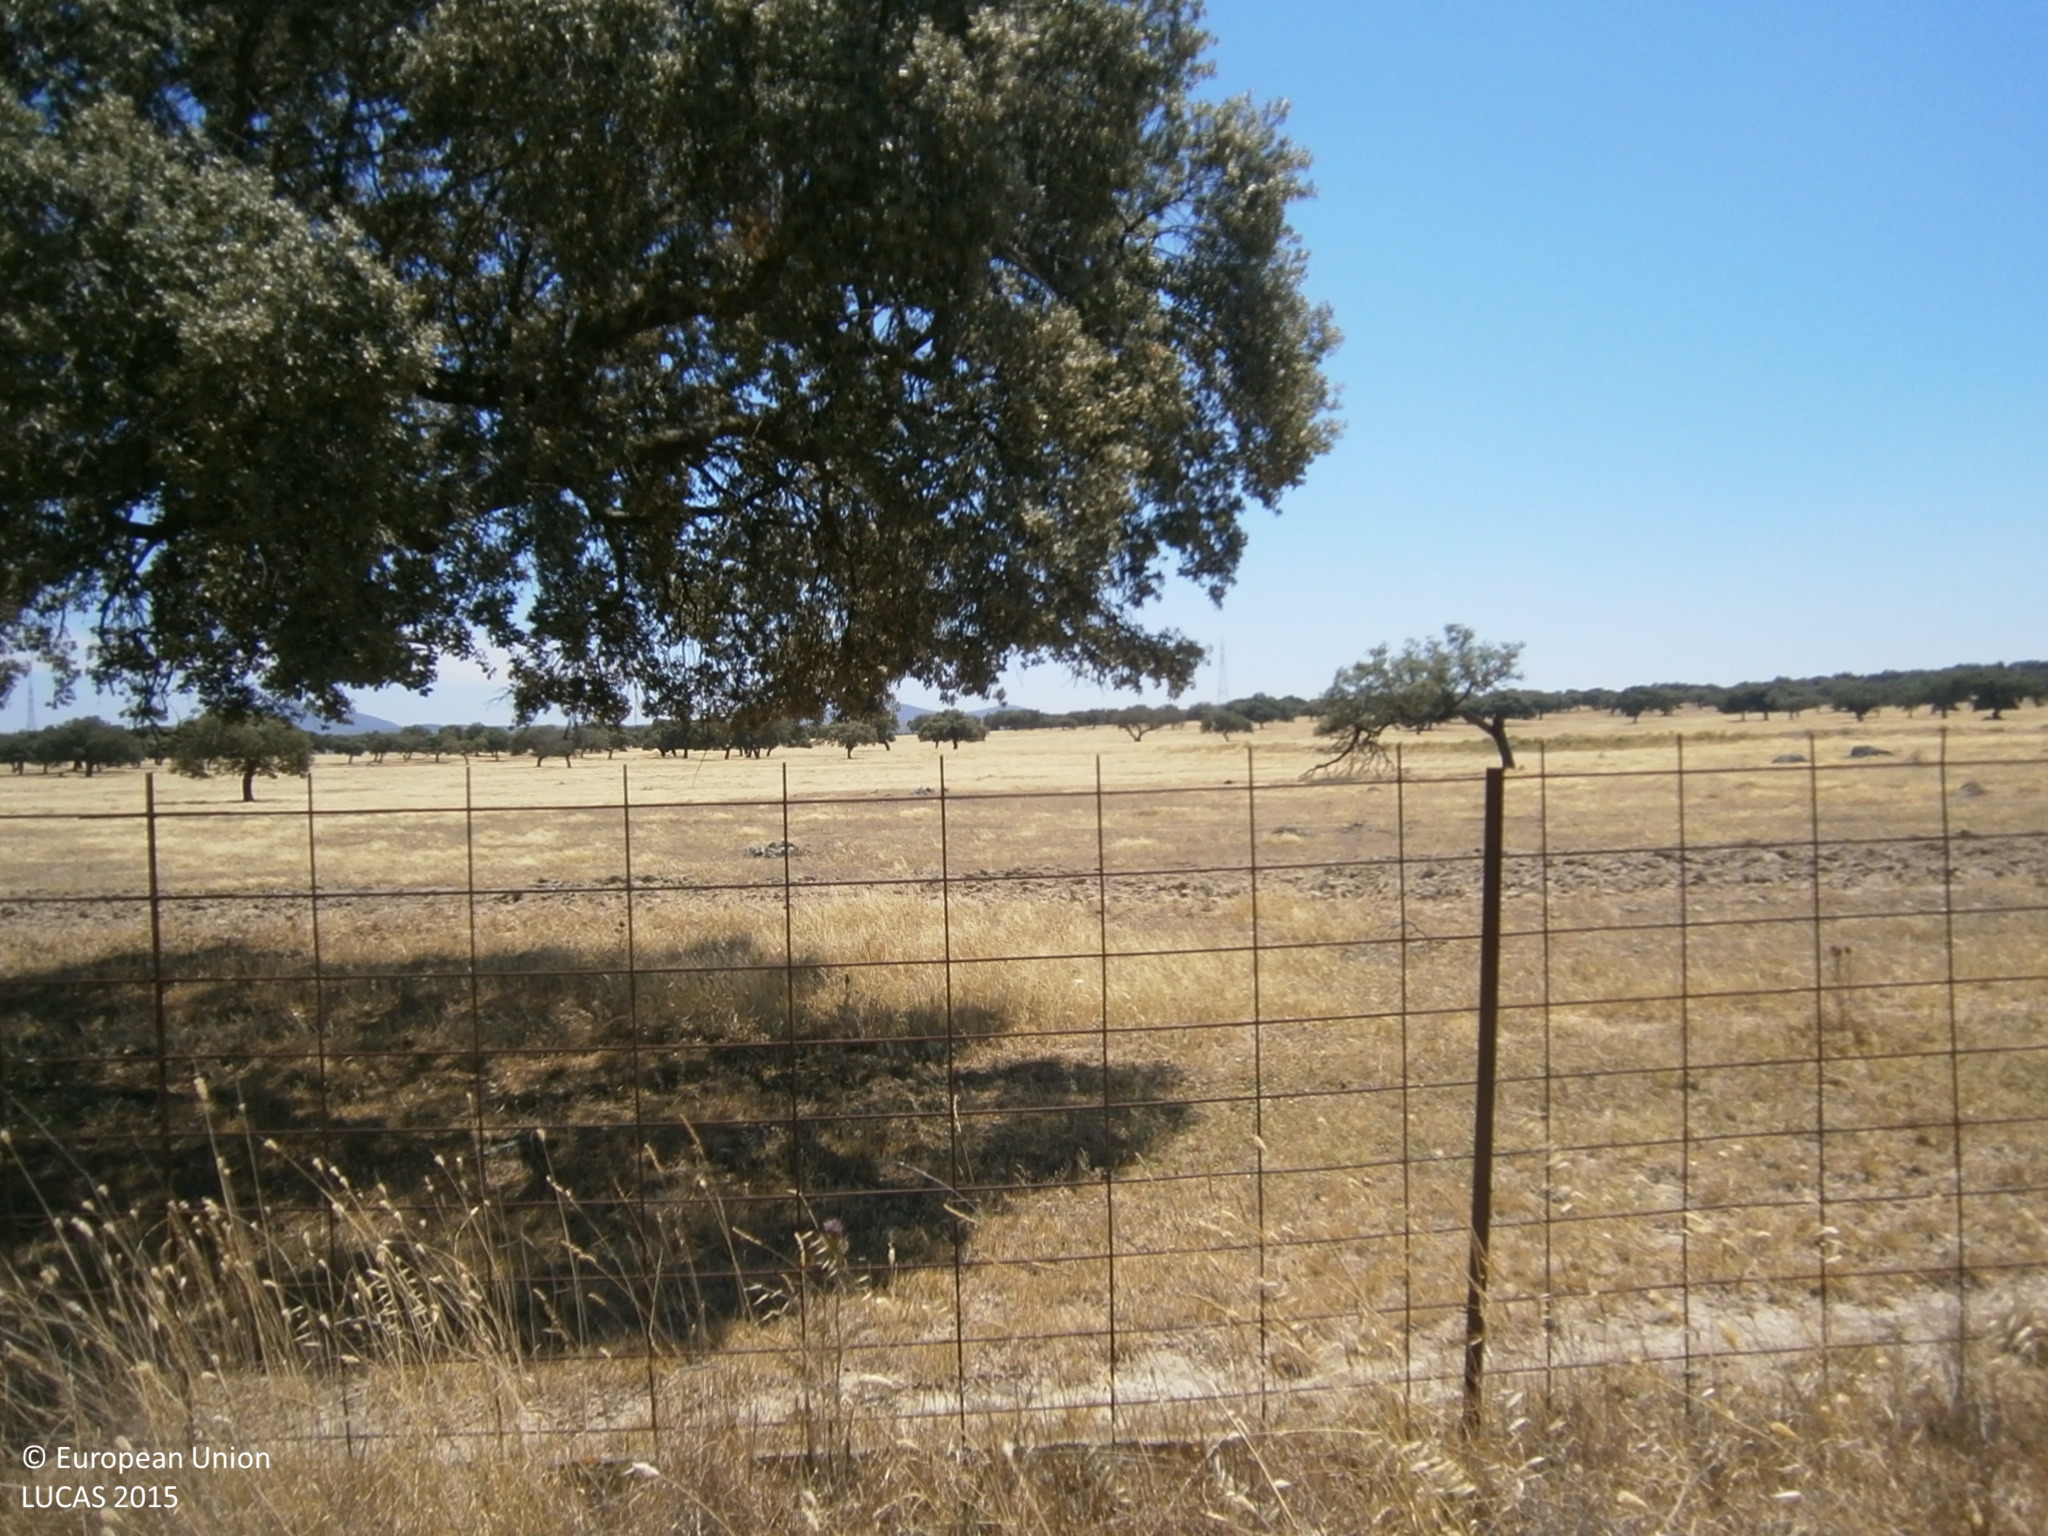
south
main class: Grassland
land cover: Grassland with sparse tree/shrub cover
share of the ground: > 75 %
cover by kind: herbaceous plants 90 %, broadleaved forest trees 5 %, shrubs 5 %
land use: Agriculture (excluding fallow land and kitchen gardens)
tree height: > 5 m
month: June
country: ES
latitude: 38.6288
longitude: -6.8684
